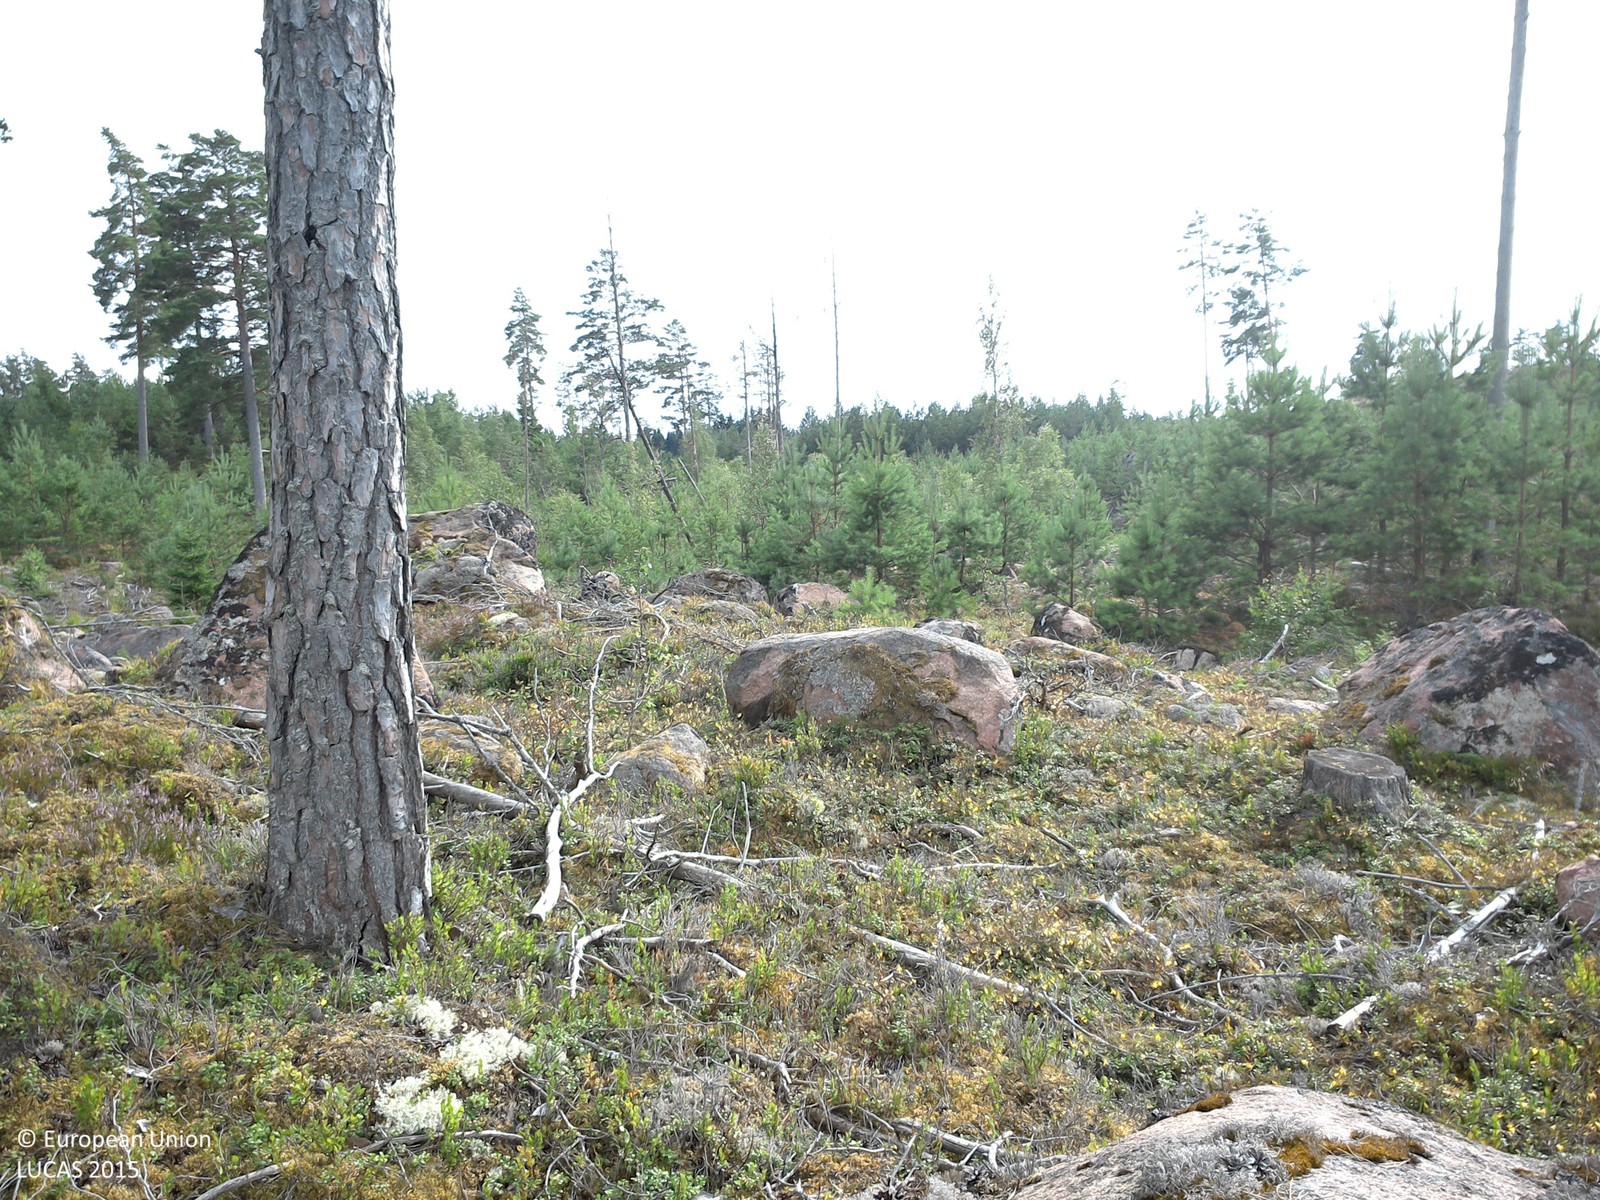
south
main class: Woodland
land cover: Pine dominated coniferous woodland
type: boreal forest
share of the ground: 10 - 25 %
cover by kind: lichens and mosses 50 %, coniferous forest trees 20 %, consolidated bare surface 15 %, broadleaved forest trees 5 %, shrubs 5 %, unconsolidated bare surface 5 %
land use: Forestry
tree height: < 5 m
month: August
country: SE
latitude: 58.2402
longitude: 14.8488
